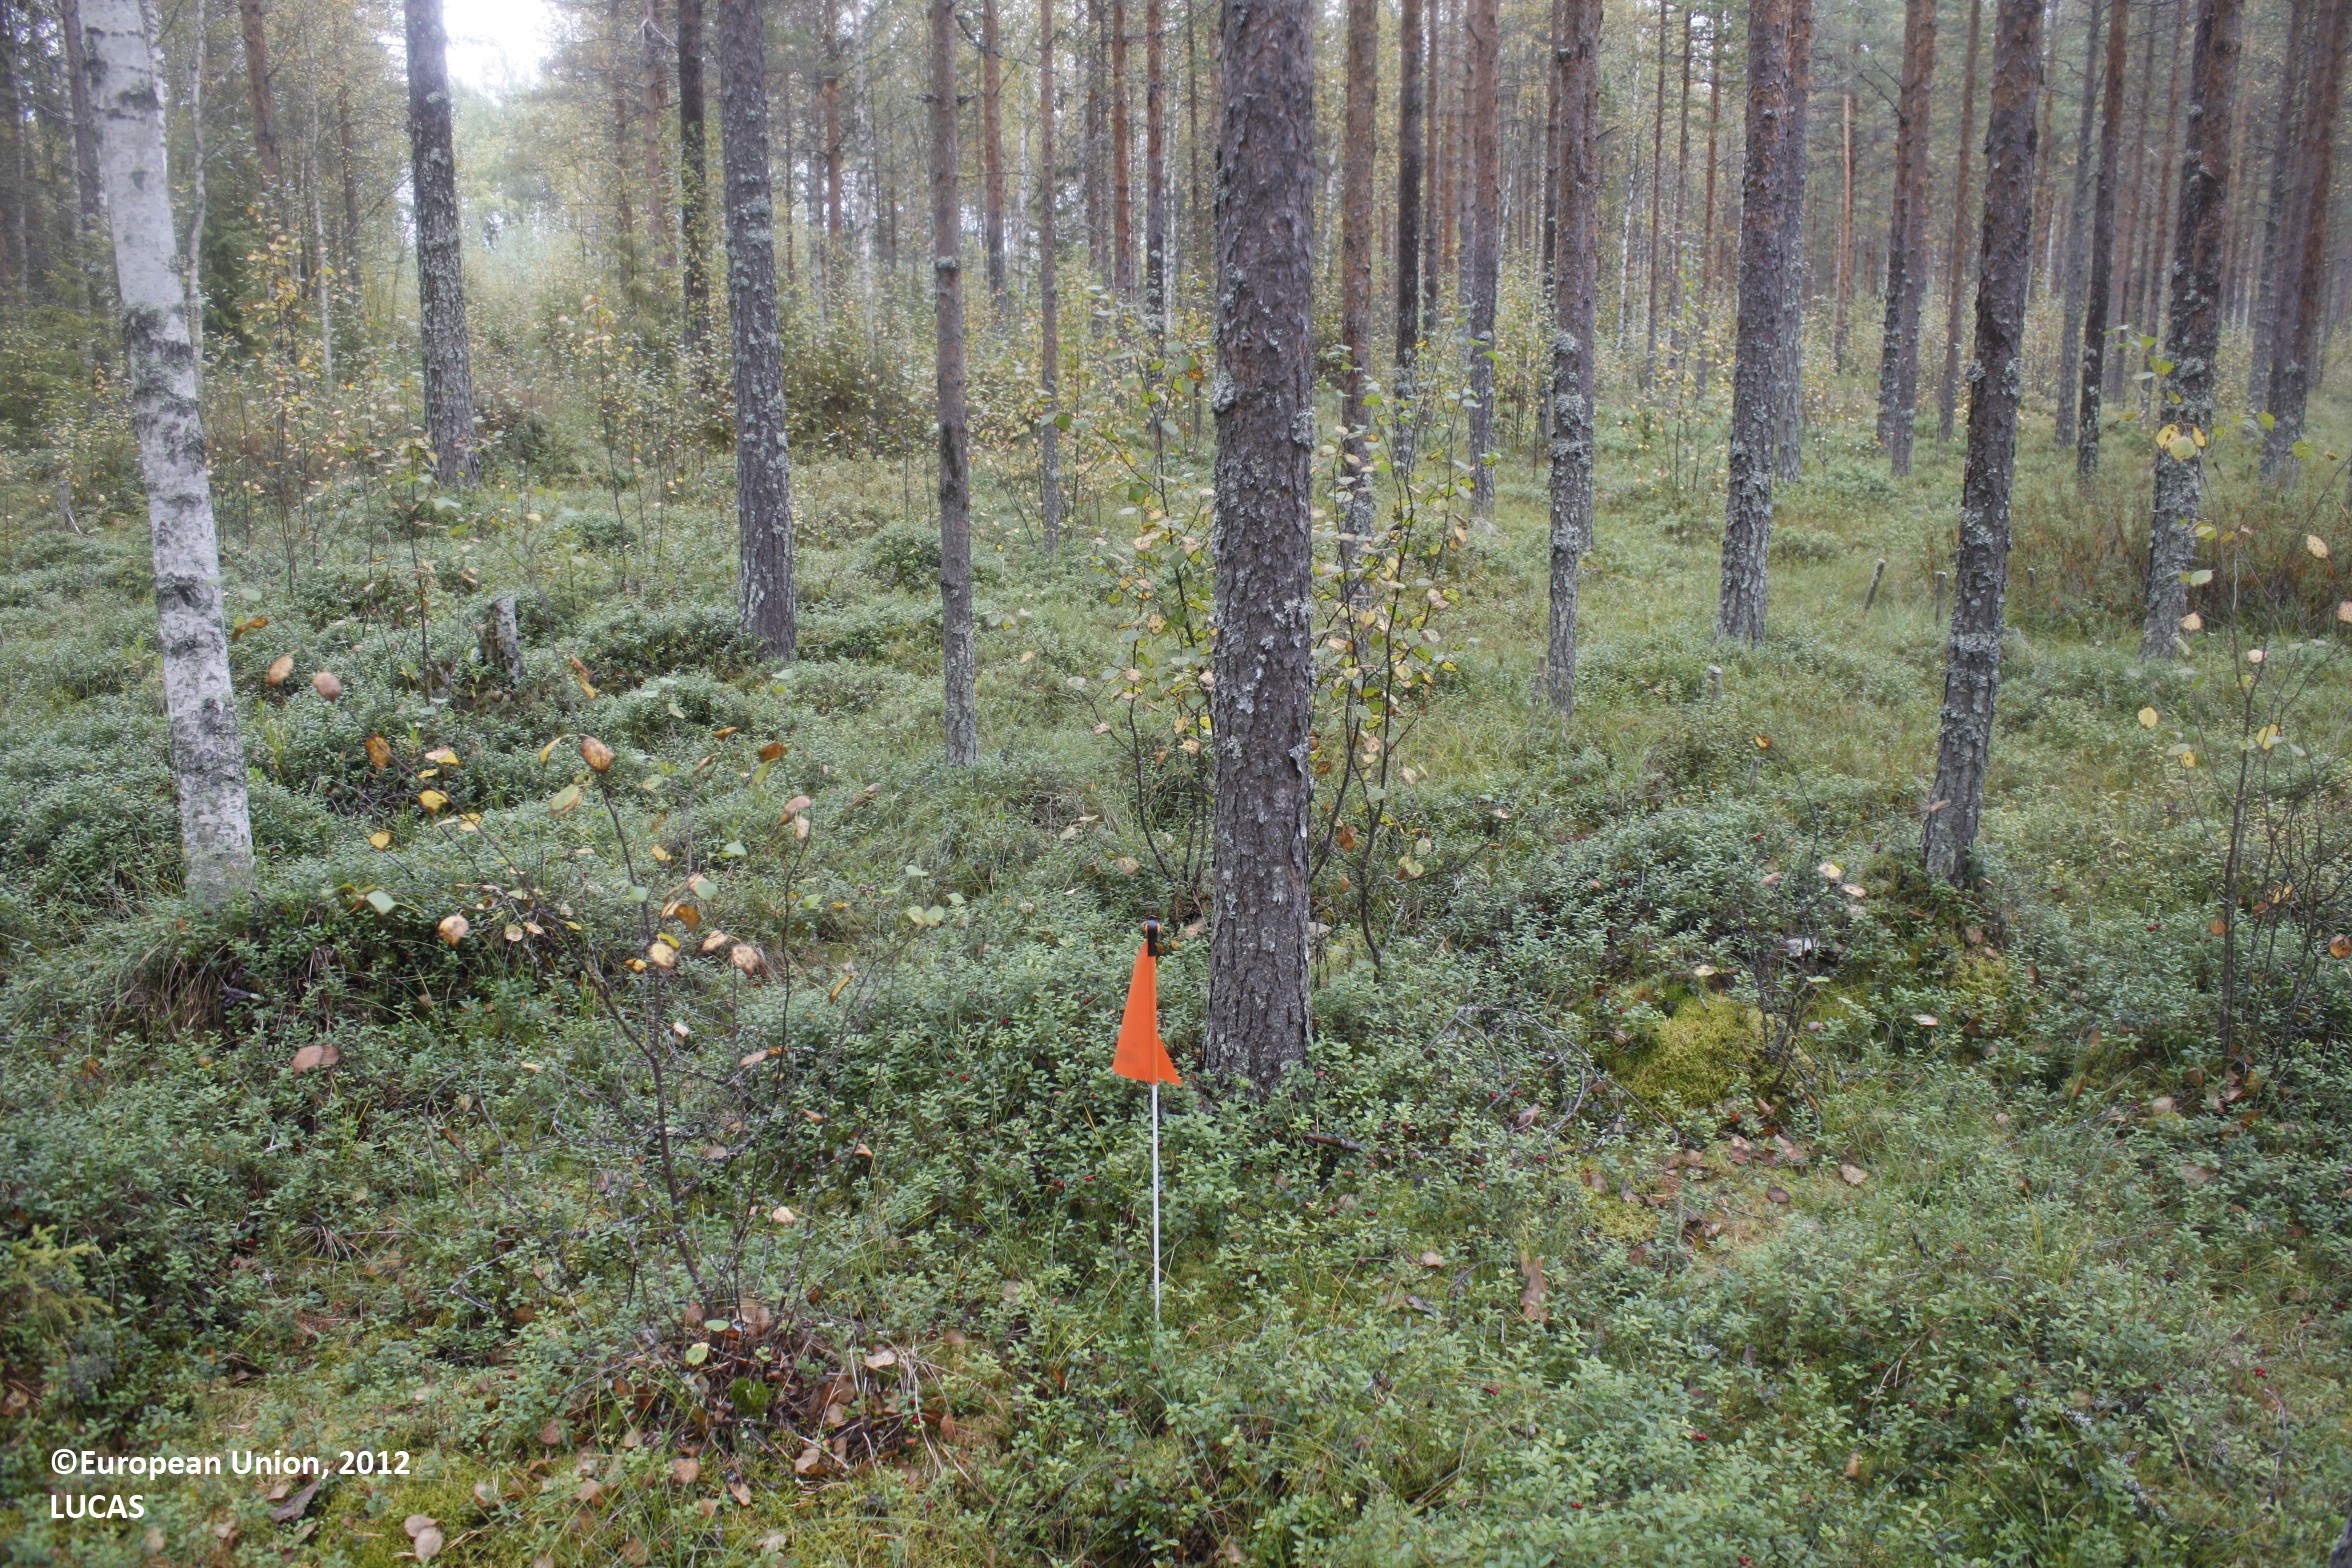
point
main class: Woodland
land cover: Pine dominated coniferous woodland
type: boreal forest
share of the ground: 50 - 75 %
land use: Forestry
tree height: > 5 m
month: September
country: FI
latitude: 65.1050
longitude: 26.6532
